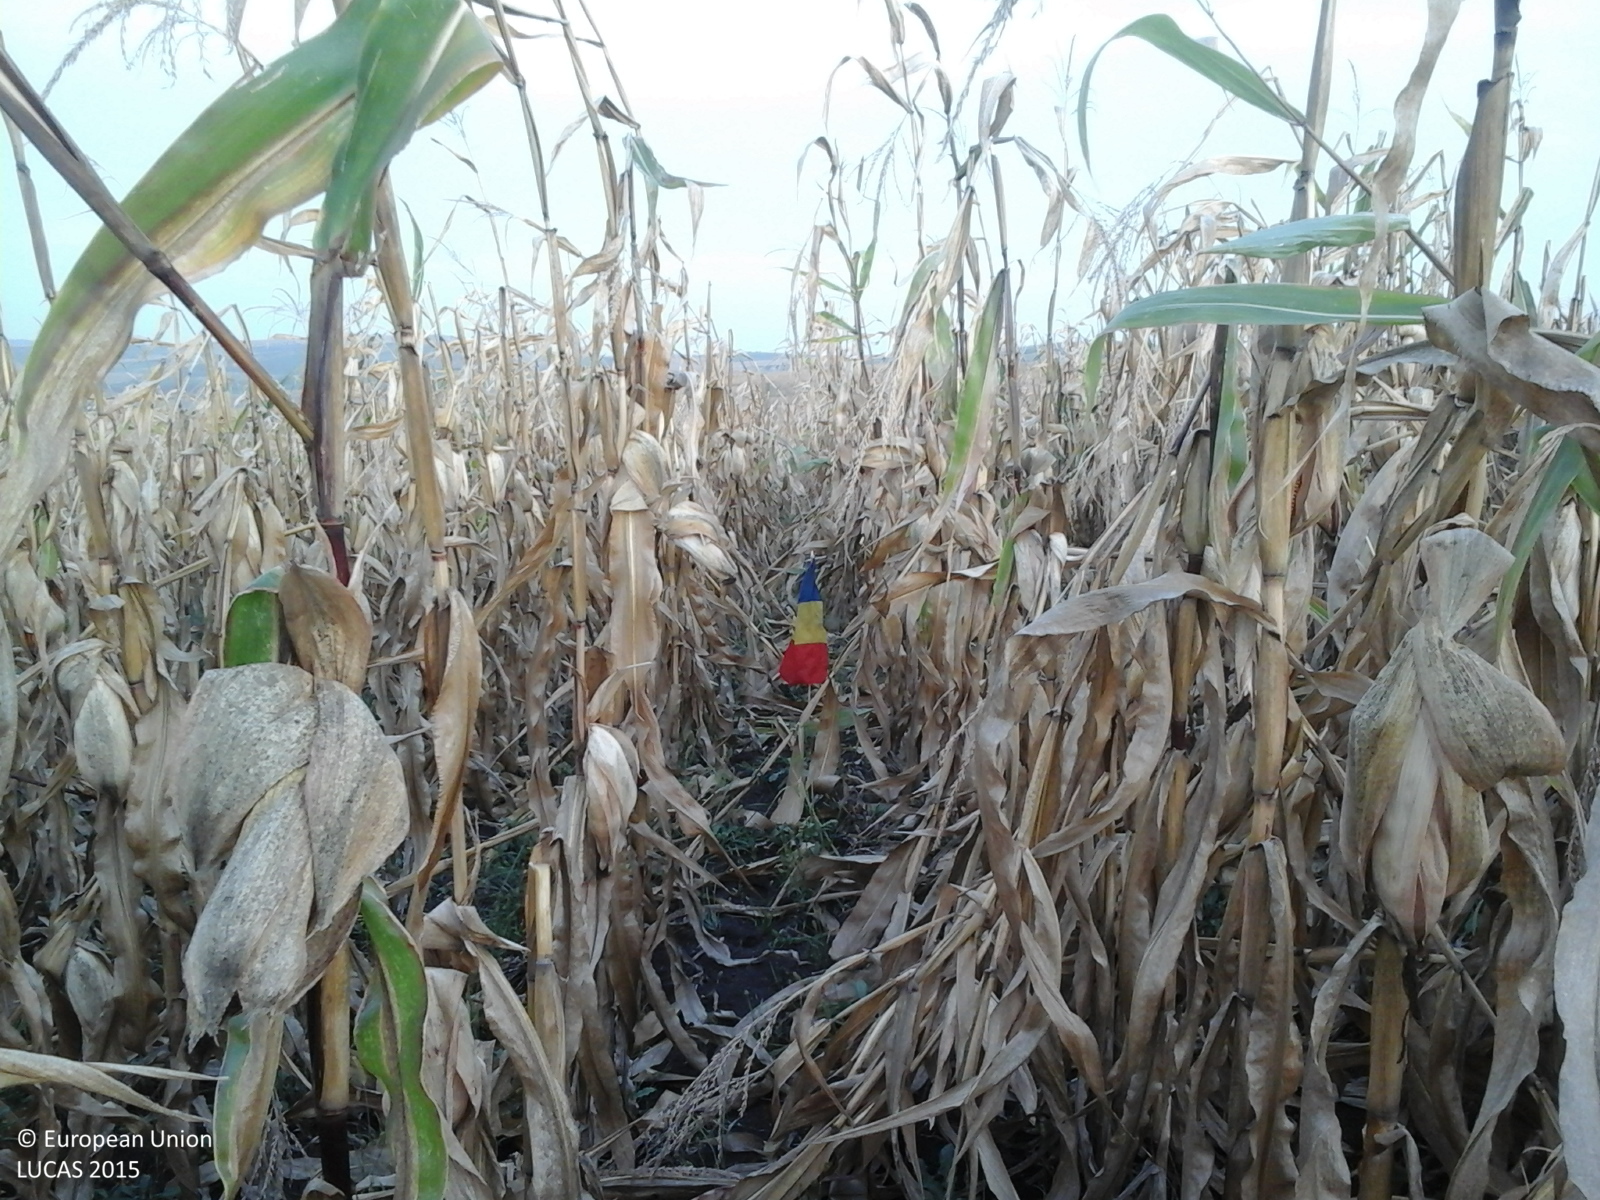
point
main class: Cropland
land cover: Maize
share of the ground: > 75 %
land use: Agriculture (excluding fallow land and kitchen gardens)
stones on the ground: < 10 %
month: September
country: RO
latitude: 46.5439
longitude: 23.9649
